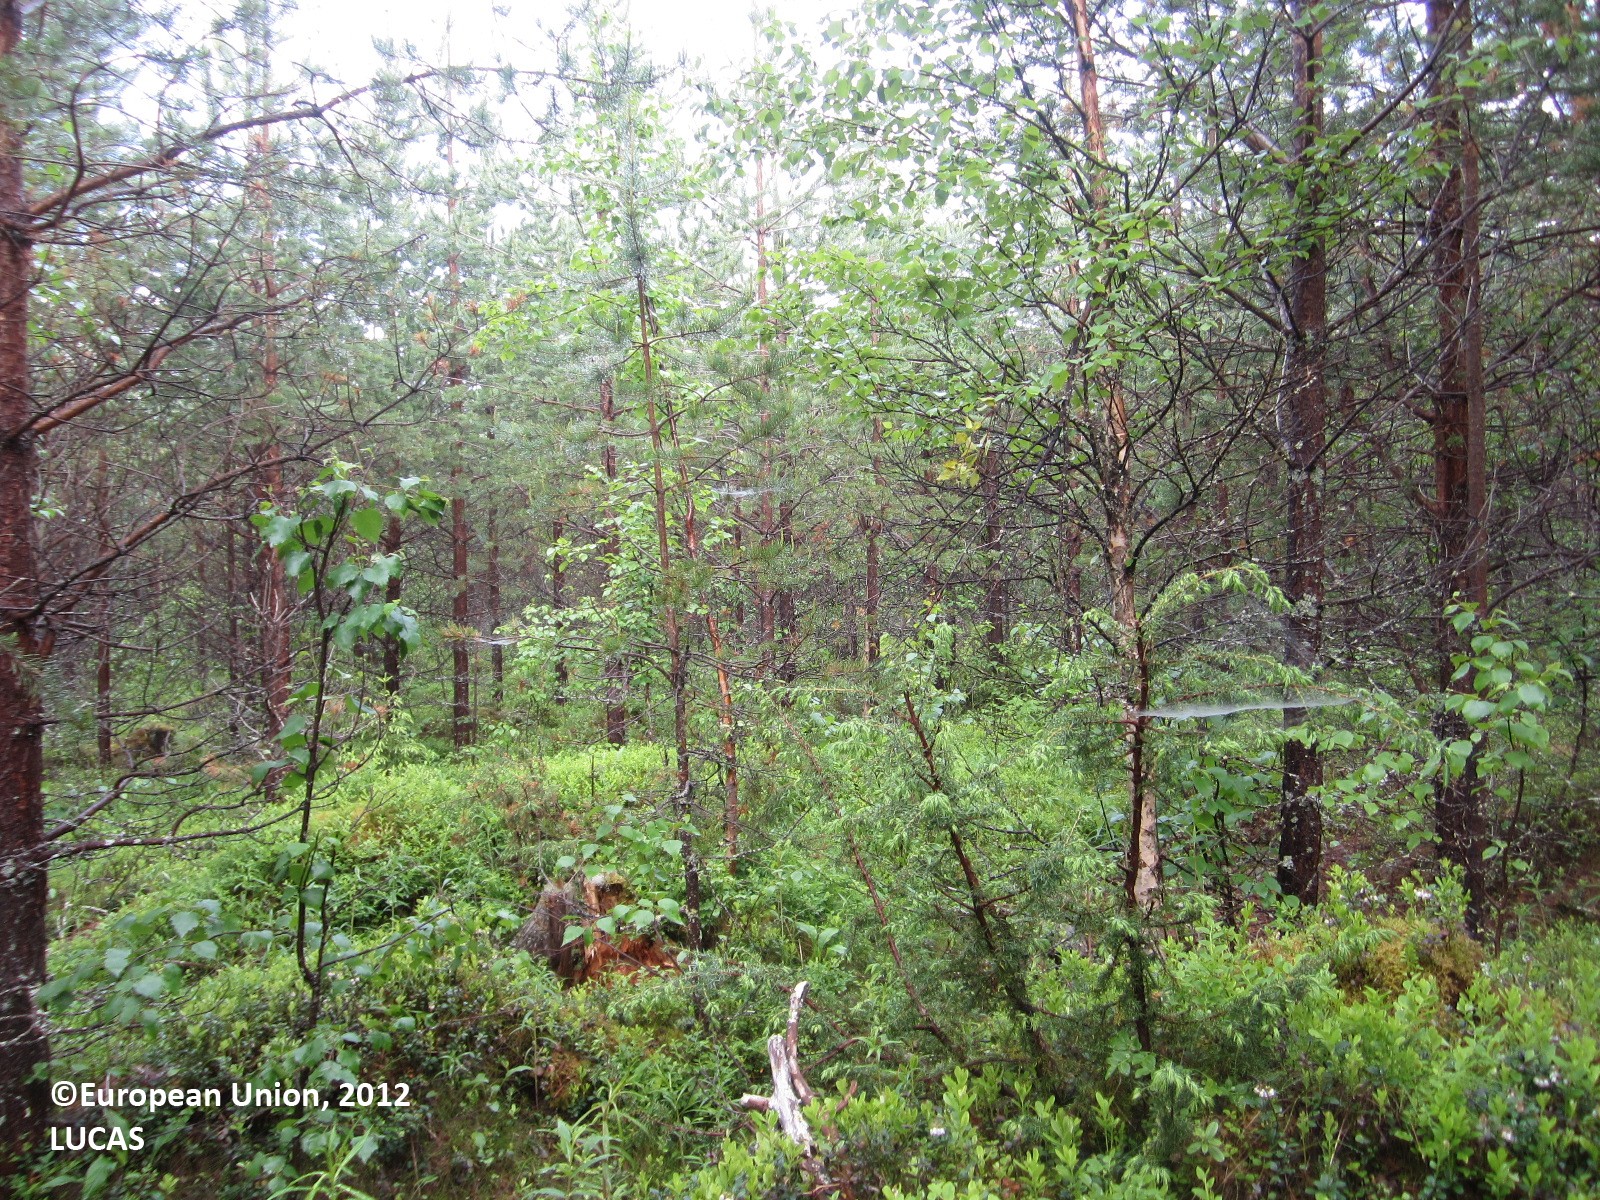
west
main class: Woodland
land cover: Pine dominated coniferous woodland
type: boreal forest
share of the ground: > 75 %
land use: Forestry
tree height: > 5 m
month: June
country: FI
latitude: 64.5097
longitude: 29.5630
